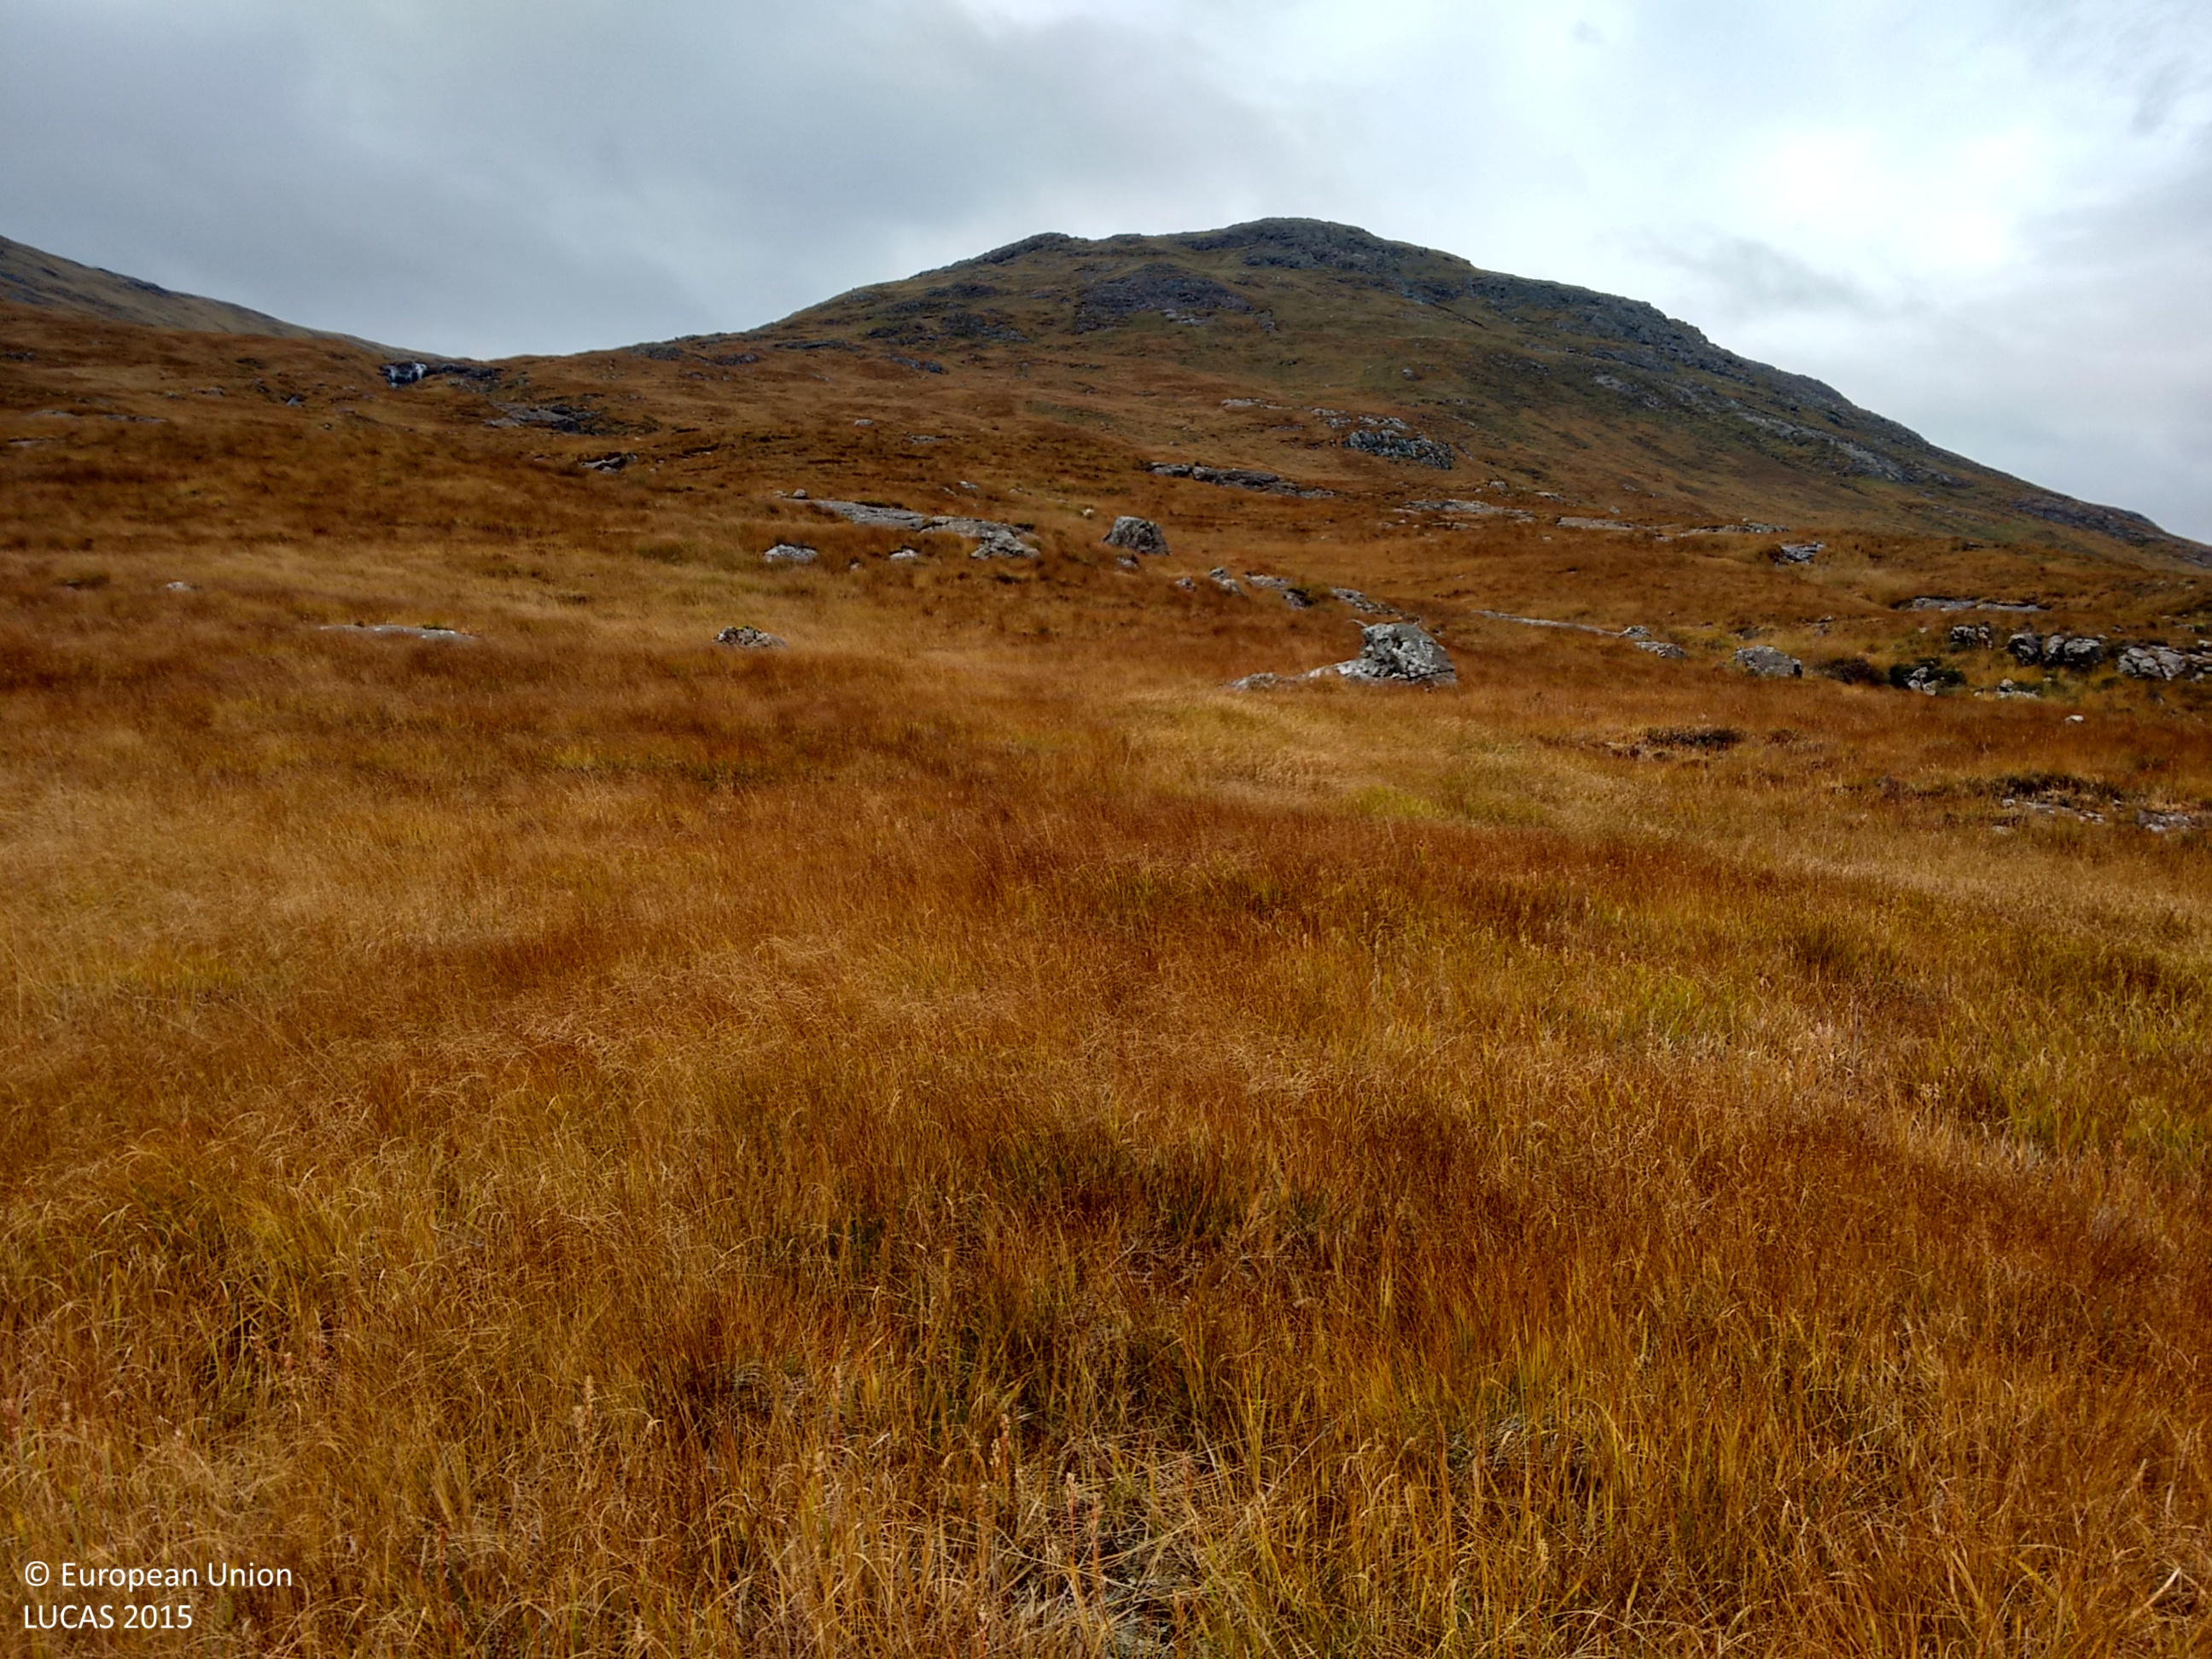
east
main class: Grassland
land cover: Grassland without tree/shrub cover
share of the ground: > 75 %
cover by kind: herbaceous plants 100 %
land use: Semi-natural and natural areas not in use
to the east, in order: Grassland without tree/shrub cover; Rivers and streams; Rock outcrops; Grassland without tree/shrub cover; Rock outcrops; Rivers and streams; Rock outcrops; Grassland without tree/shrub cover
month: October
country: GB
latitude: 56.4292
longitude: -5.8087
